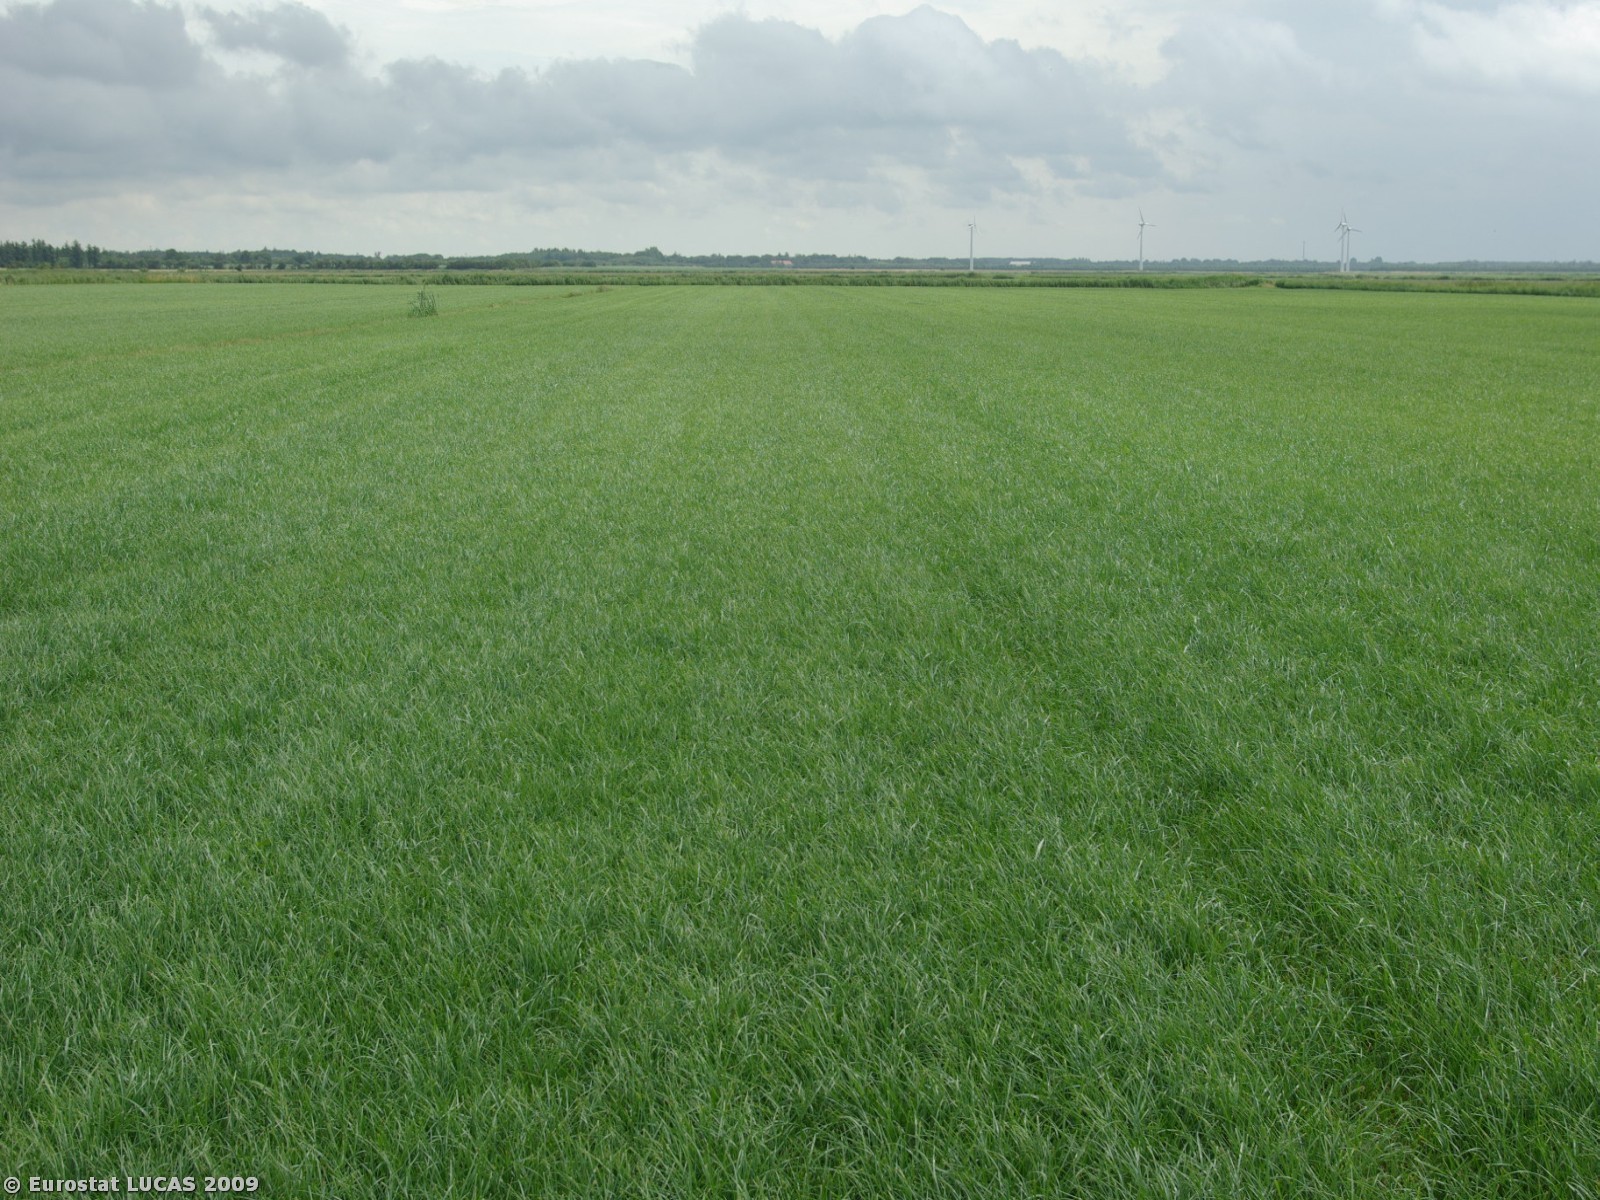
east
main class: Cropland
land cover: Temporary grasslands
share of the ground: > 75 %
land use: Agriculture (excluding fallow land and kitchen gardens)
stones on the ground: < 10 %
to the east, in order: Temporary grasslands; Ditches and canals; Grass margins; Temporary grasslands
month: July
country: DK
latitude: 55.2819
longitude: 8.6629
